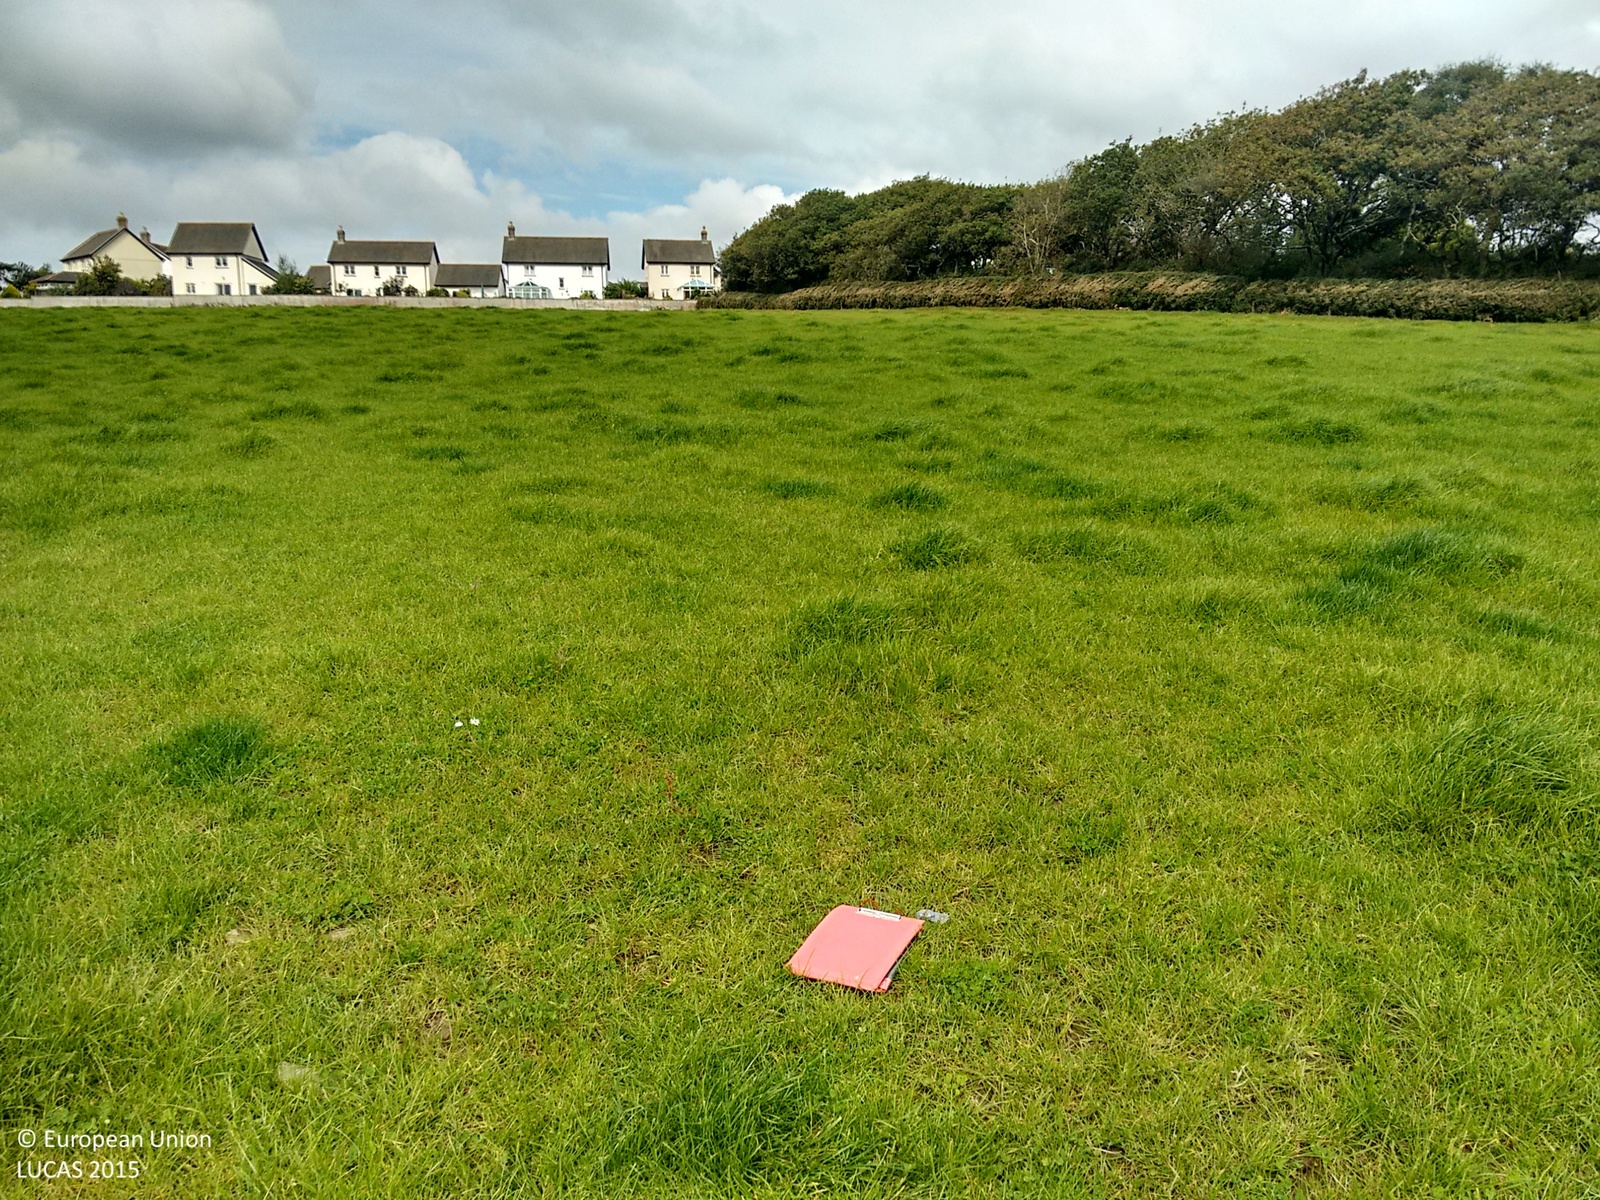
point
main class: Grassland
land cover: Grassland without tree/shrub cover
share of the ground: > 75 %
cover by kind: herbaceous plants 100 %
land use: Agriculture (excluding fallow land and kitchen gardens)
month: September
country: GB
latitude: 50.8000
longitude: -4.3903
